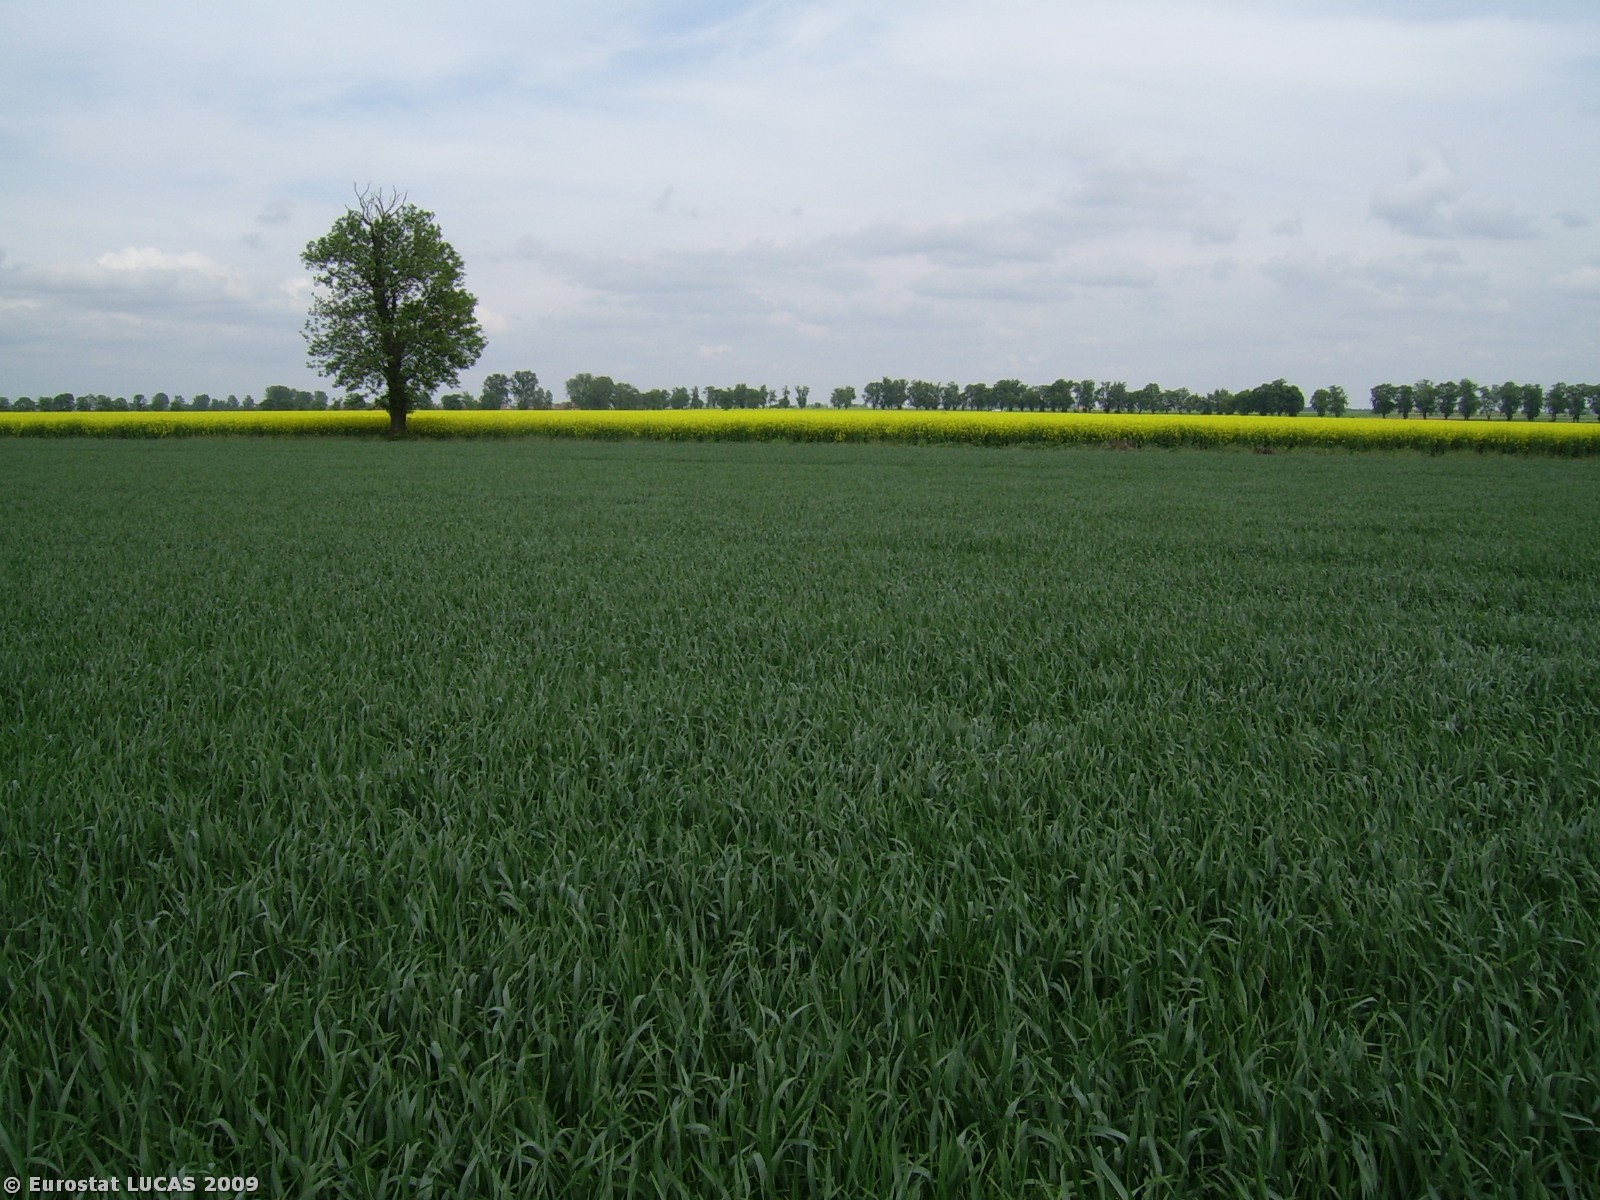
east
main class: Cropland
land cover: Common wheat
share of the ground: > 75 %
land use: Agriculture (excluding fallow land and kitchen gardens)
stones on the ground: < 10 %
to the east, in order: Common wheat; Grassland without tree/shrub cover; Tracks; Grassland without tree/shrub cover; Rape and turnip rape
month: May
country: PL
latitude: 51.8175
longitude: 16.8711
